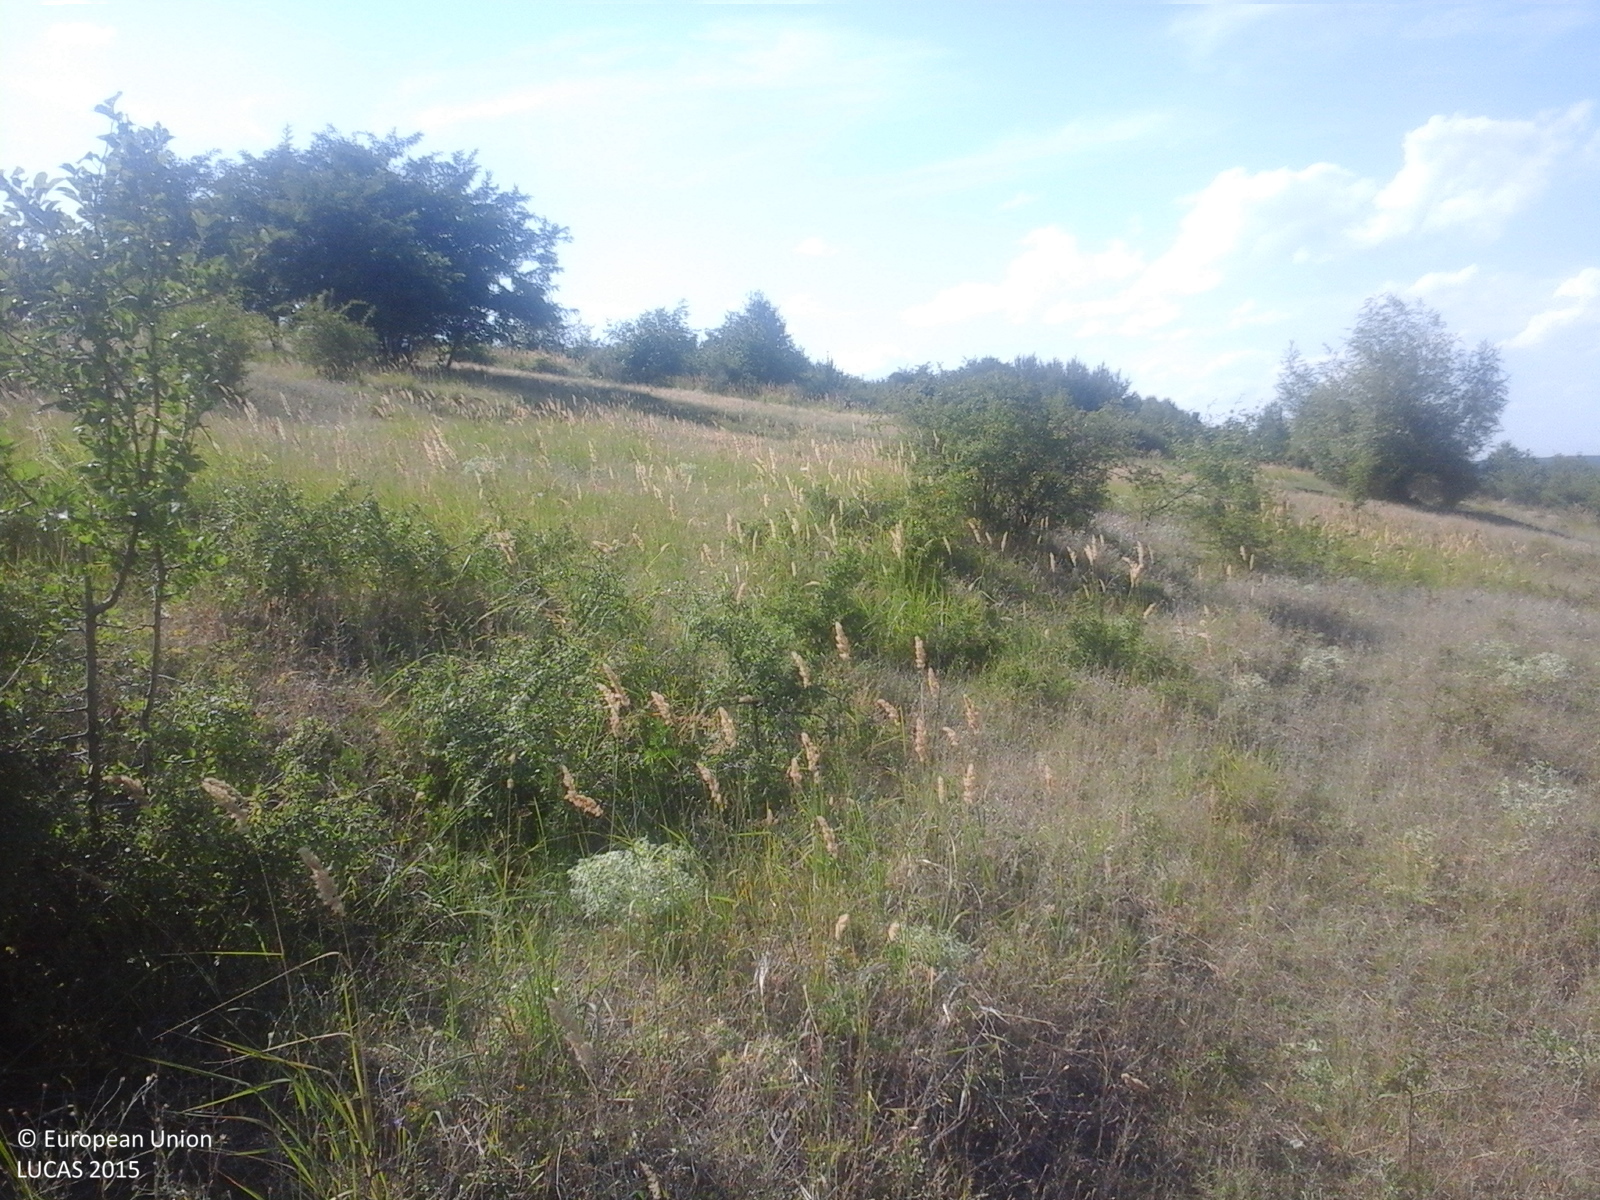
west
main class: Grassland
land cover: Grassland with sparse tree/shrub cover
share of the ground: > 75 %
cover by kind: herbaceous plants 85 %, shrubs 10 %, broadleaved forest trees 5 %
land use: Agriculture (excluding fallow land and kitchen gardens)
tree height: < 5 m
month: July
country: RO
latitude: 46.4748
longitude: 27.9549
